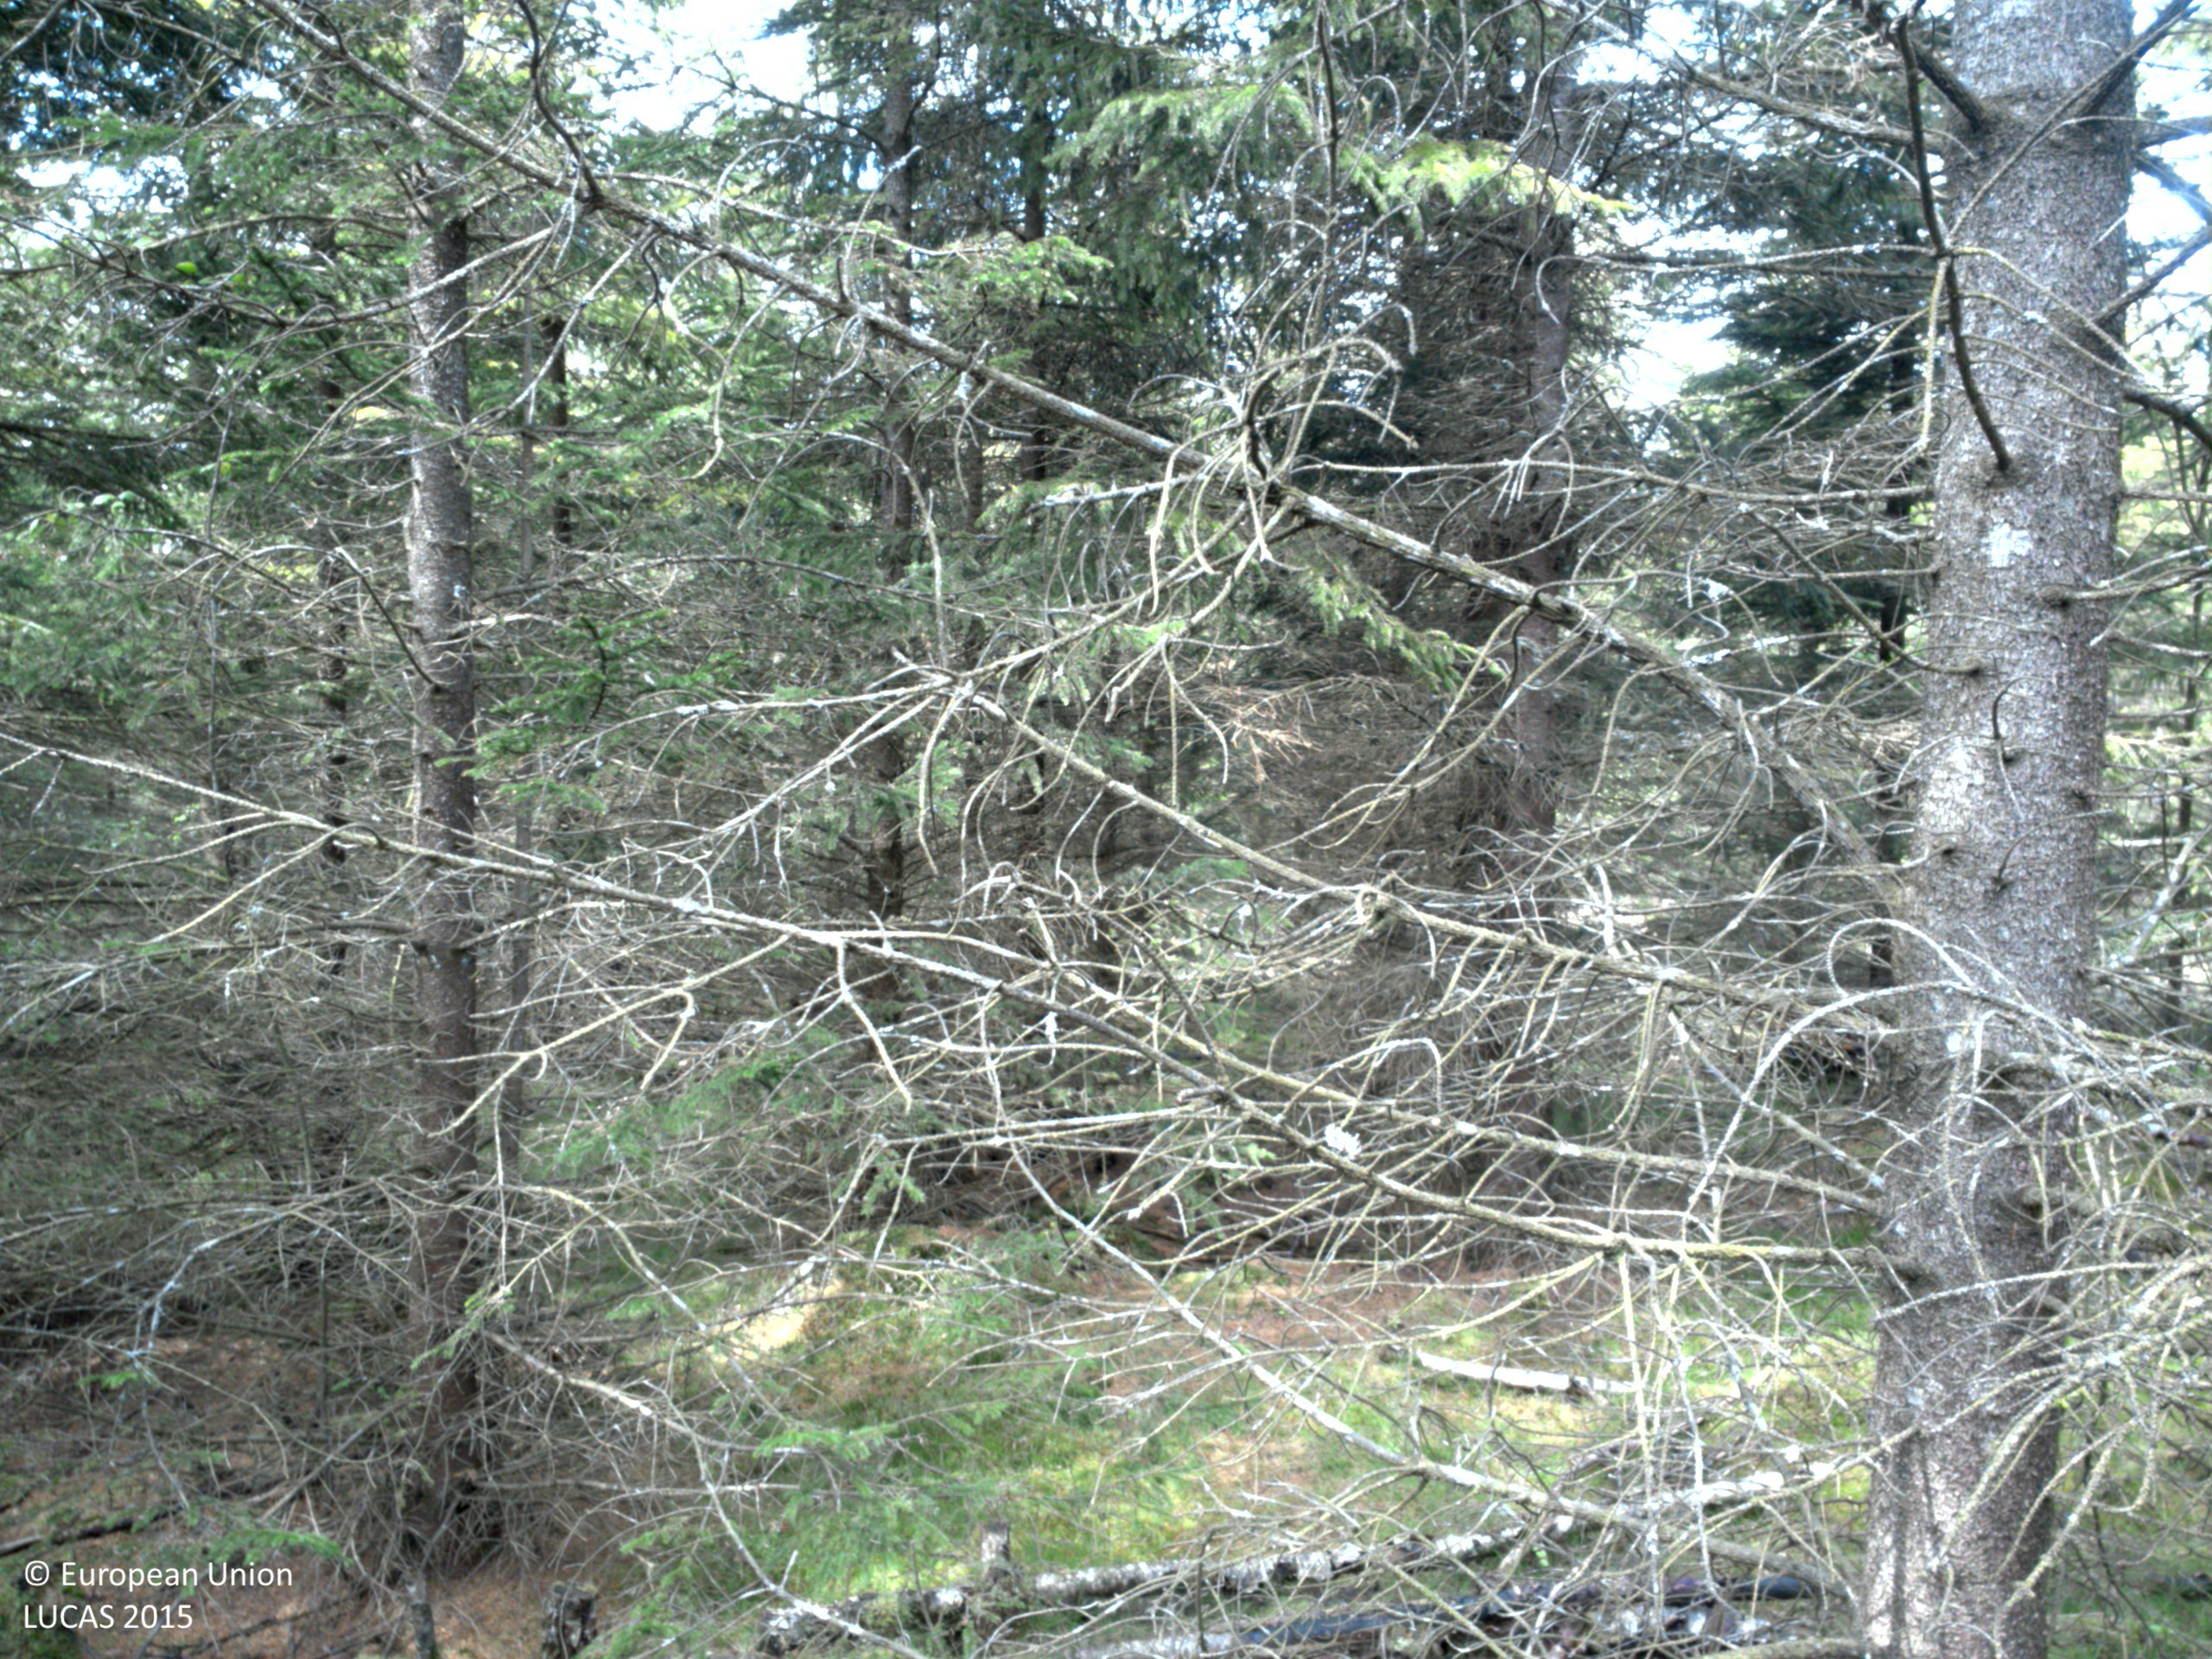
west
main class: Woodland
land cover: Spruce dominated coniferous woodland
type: boreal forest
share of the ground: > 75 %
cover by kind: coniferous forest trees 90 %, lichens and mosses 10 %
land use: Forestry
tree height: > 5 m
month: May
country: SE
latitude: 57.7338
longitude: 12.1965
